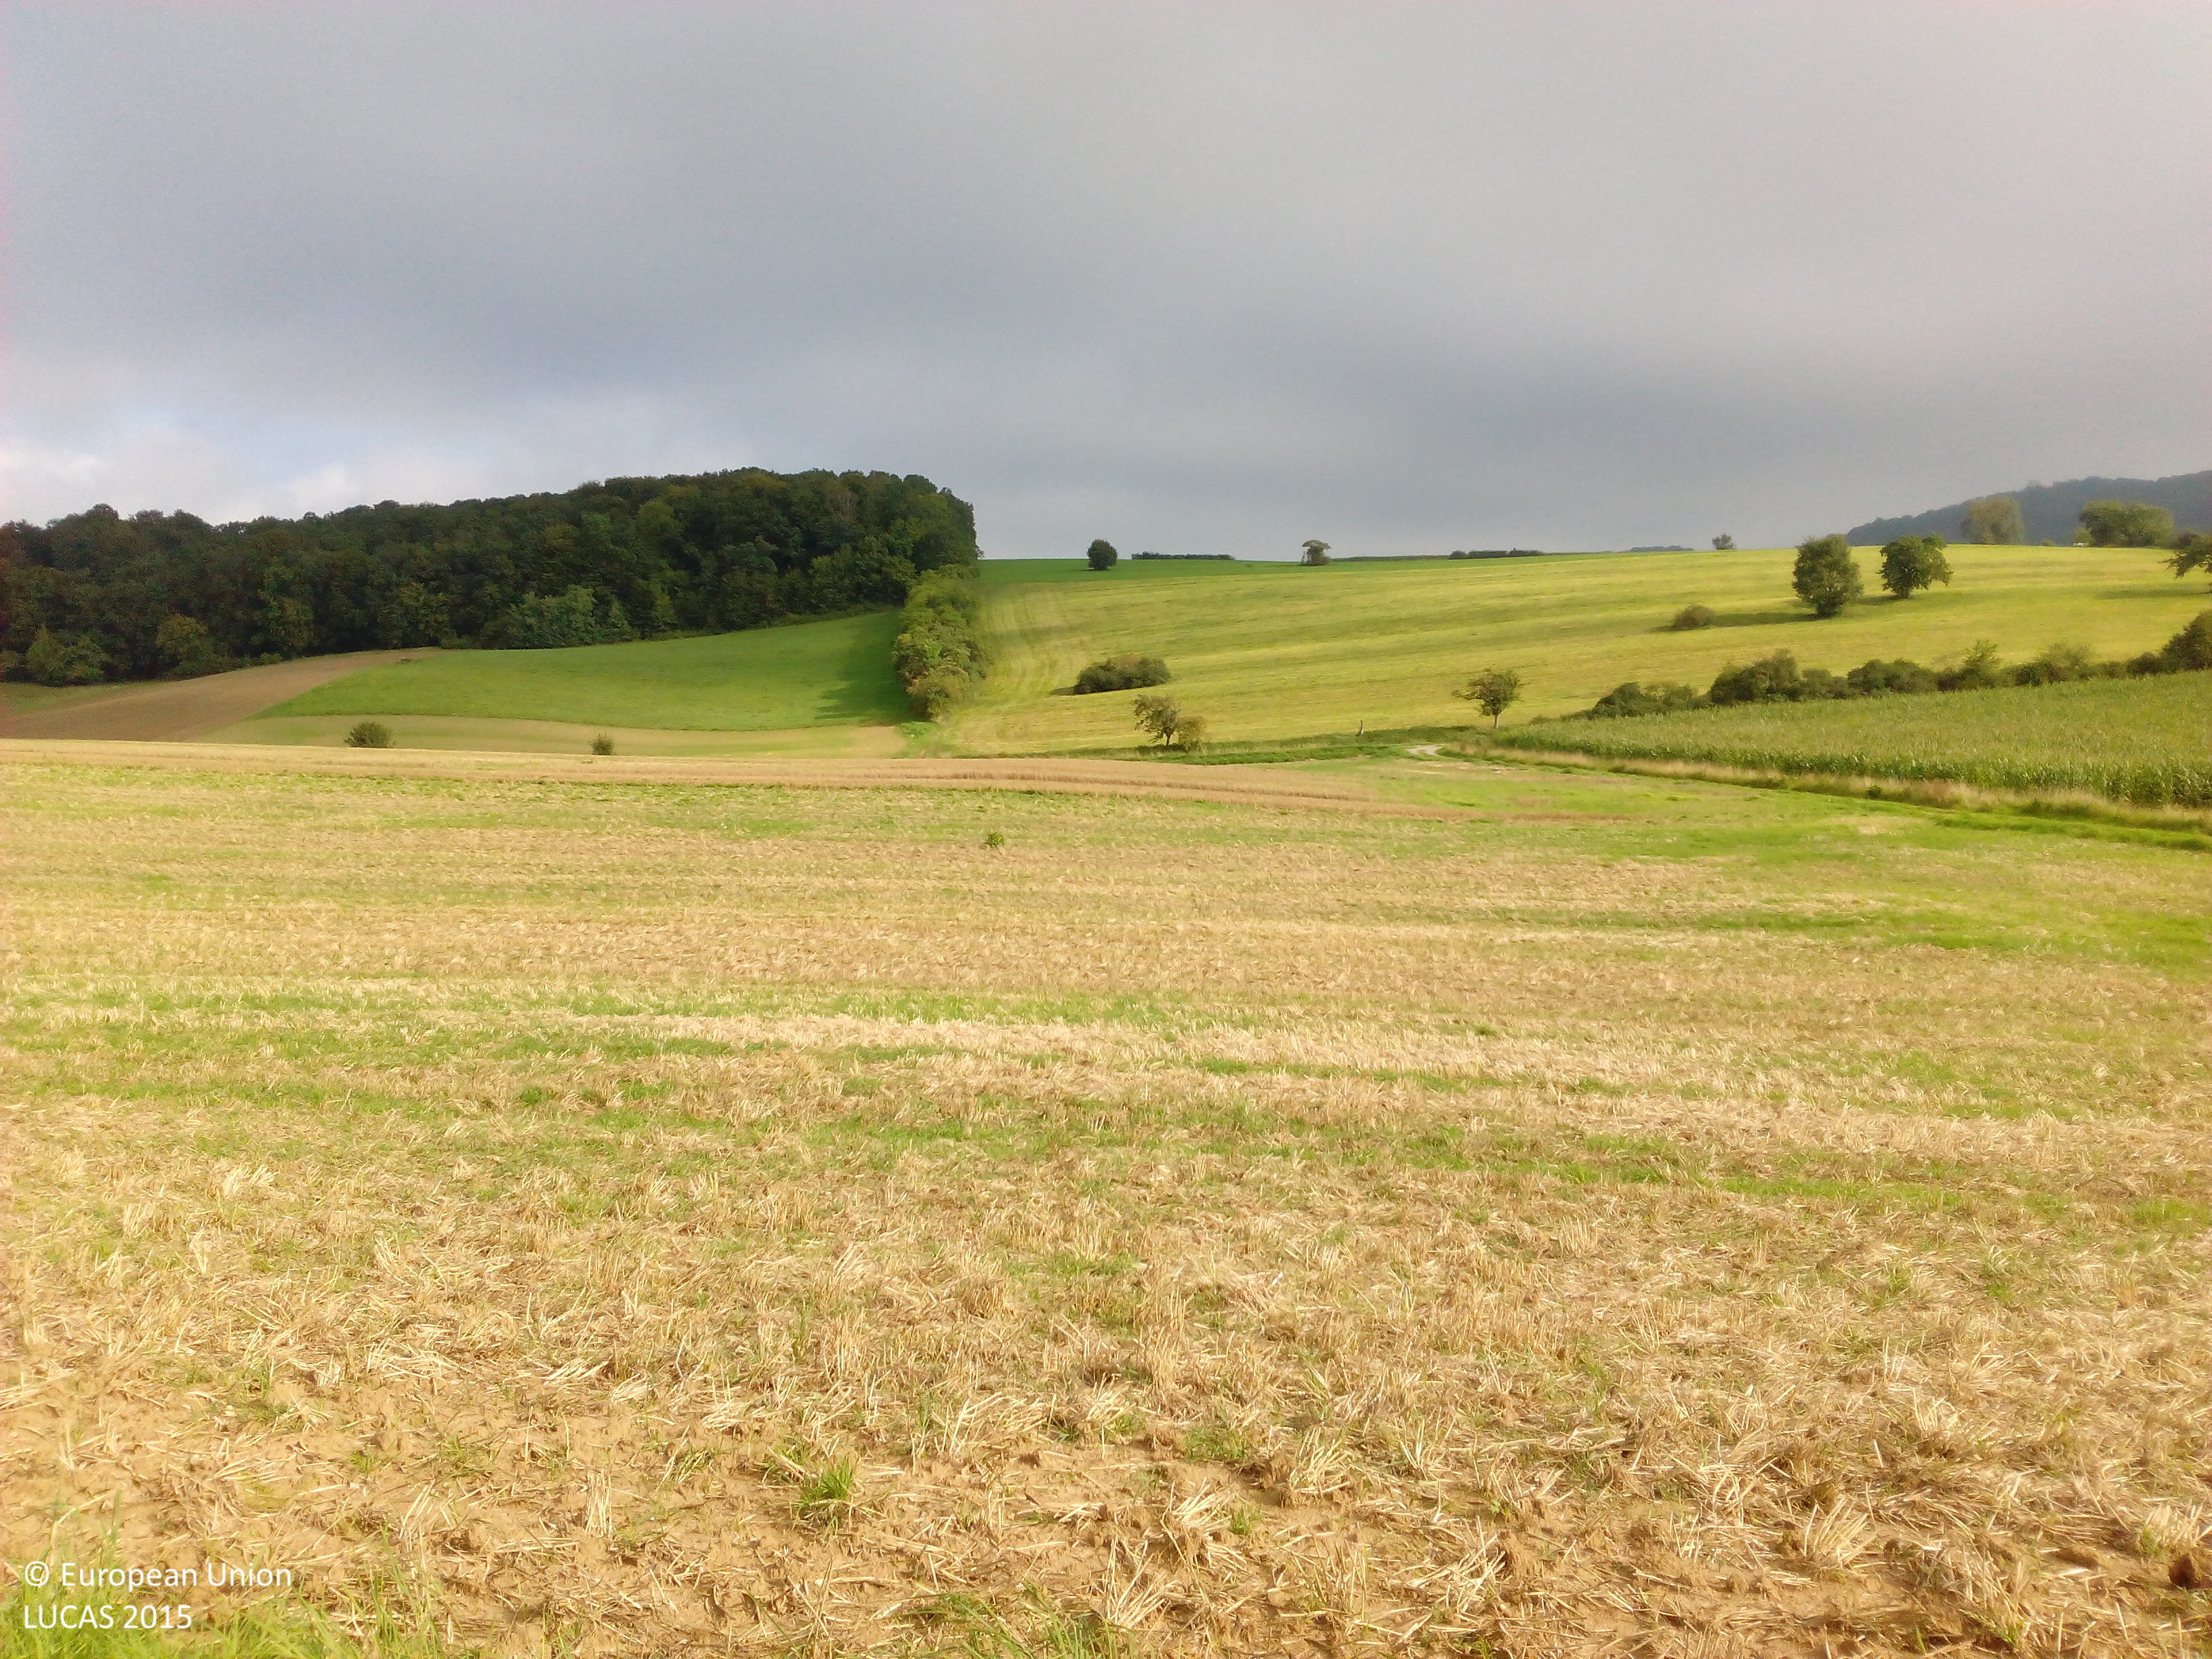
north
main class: Grassland
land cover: Grassland with sparse tree/shrub cover
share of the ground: > 75 %
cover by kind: herbaceous plants 90 %, broadleaved forest trees 5 %, shrubs 5 %
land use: Agriculture (excluding fallow land and kitchen gardens)
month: September
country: DE
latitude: 51.4068
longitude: 9.9569
